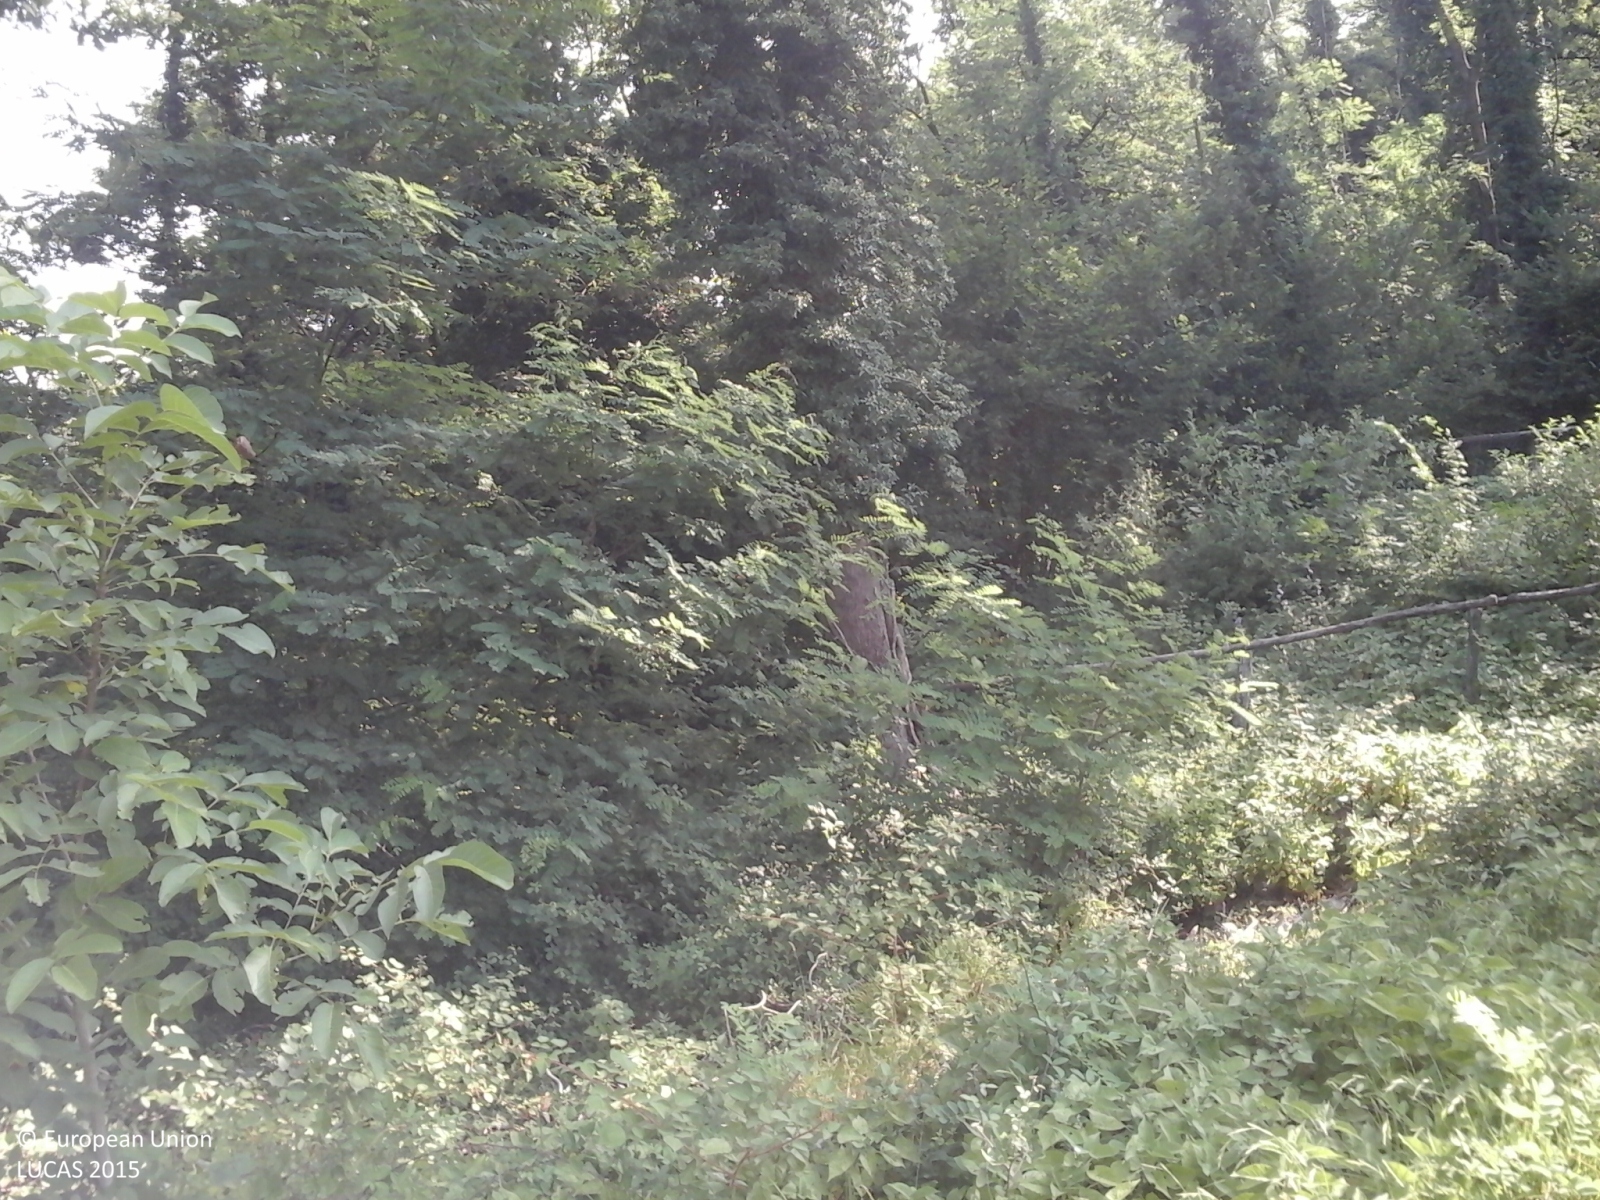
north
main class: Woodland
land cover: Broadleaved woodland
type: thermophilous deciduous forest
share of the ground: > 75 %
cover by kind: broadleaved forest trees 80 %, herbaceous plants 20 %
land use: Forestry
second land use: Amenities, museums, leisure
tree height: > 5 m
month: July
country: IT
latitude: 45.9469
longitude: 8.6990
